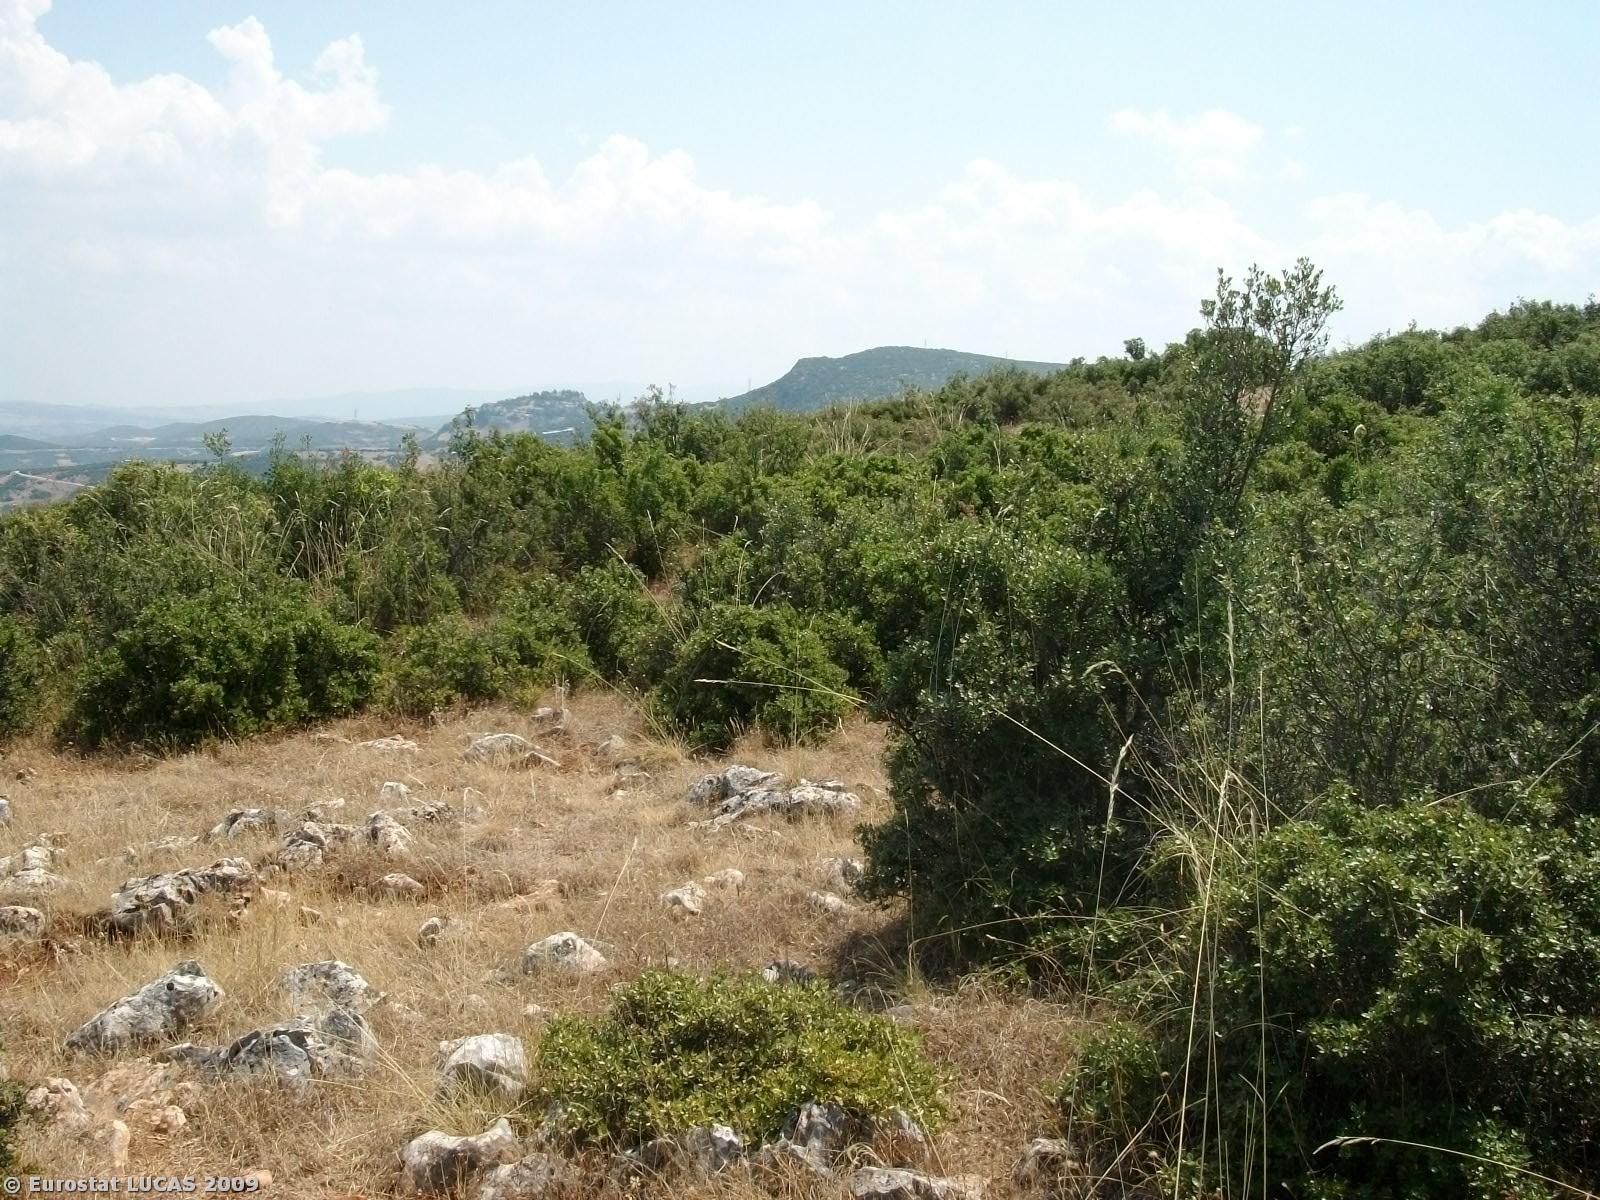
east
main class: Shrubland
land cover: Shrubland without tree cover
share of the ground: 50 - 75 %
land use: Unused
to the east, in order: Shrubland without tree cover; Rock outcrops; Shrubland without tree cover
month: August
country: GR
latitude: 39.1301
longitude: 22.2557
